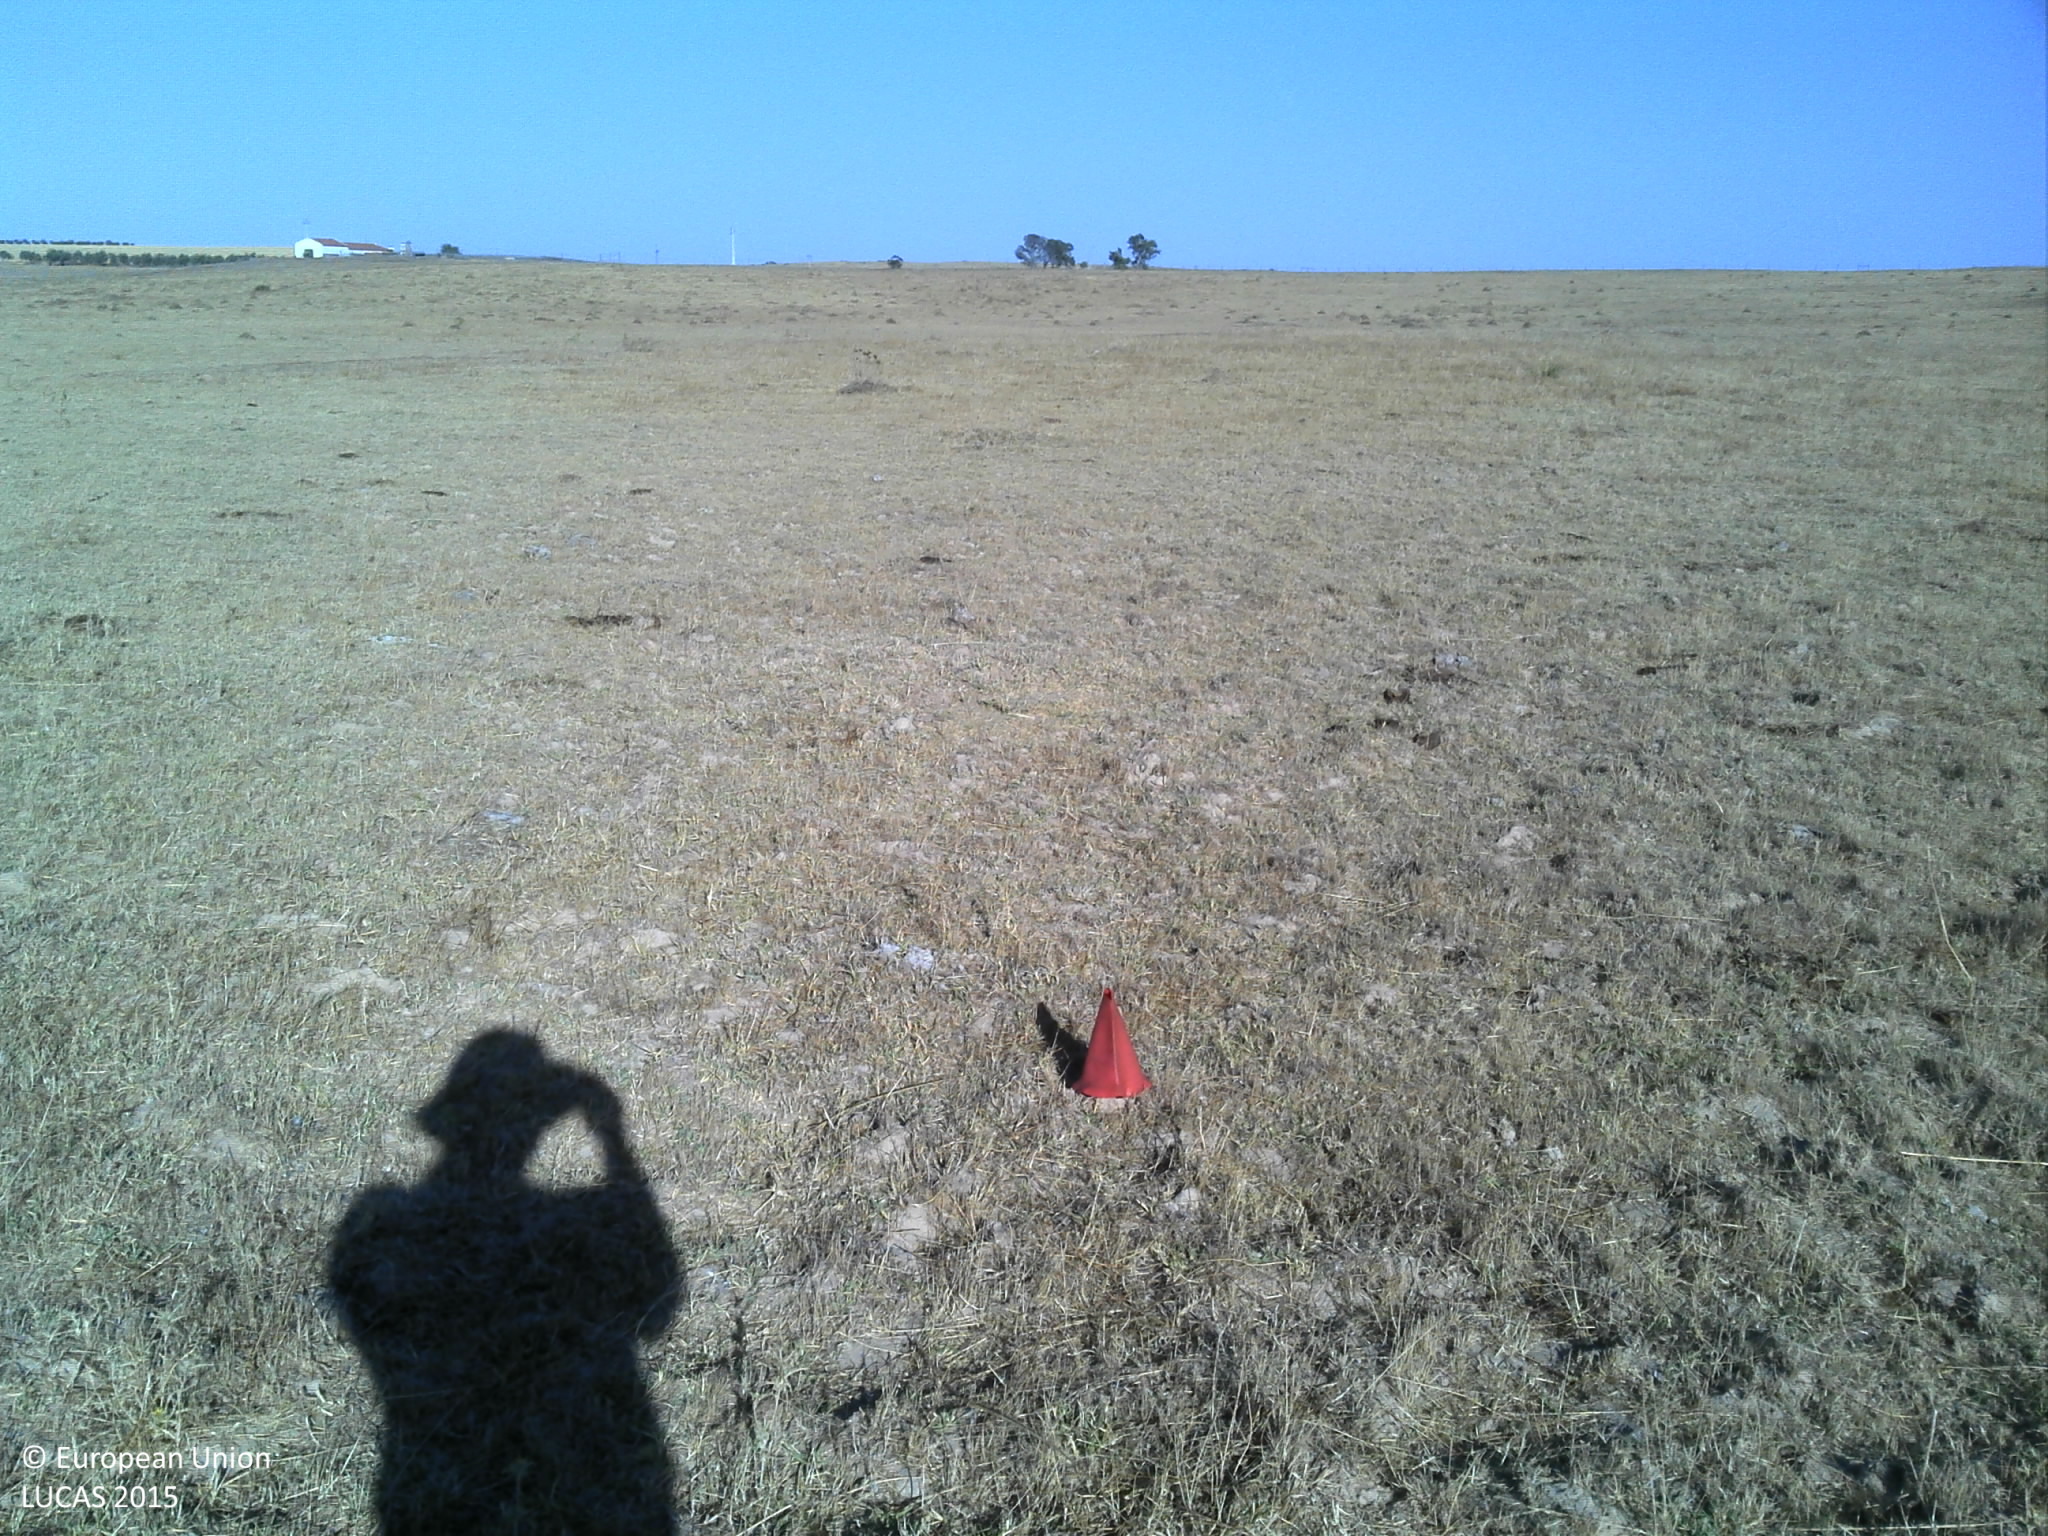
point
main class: Grassland
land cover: Grassland without tree/shrub cover
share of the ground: 10 - 25 %
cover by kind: unconsolidated bare surface 80 %, herbaceous plants 20 %
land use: Agriculture (excluding fallow land and kitchen gardens)
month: July
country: PT
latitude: 38.1065
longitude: -7.9012
